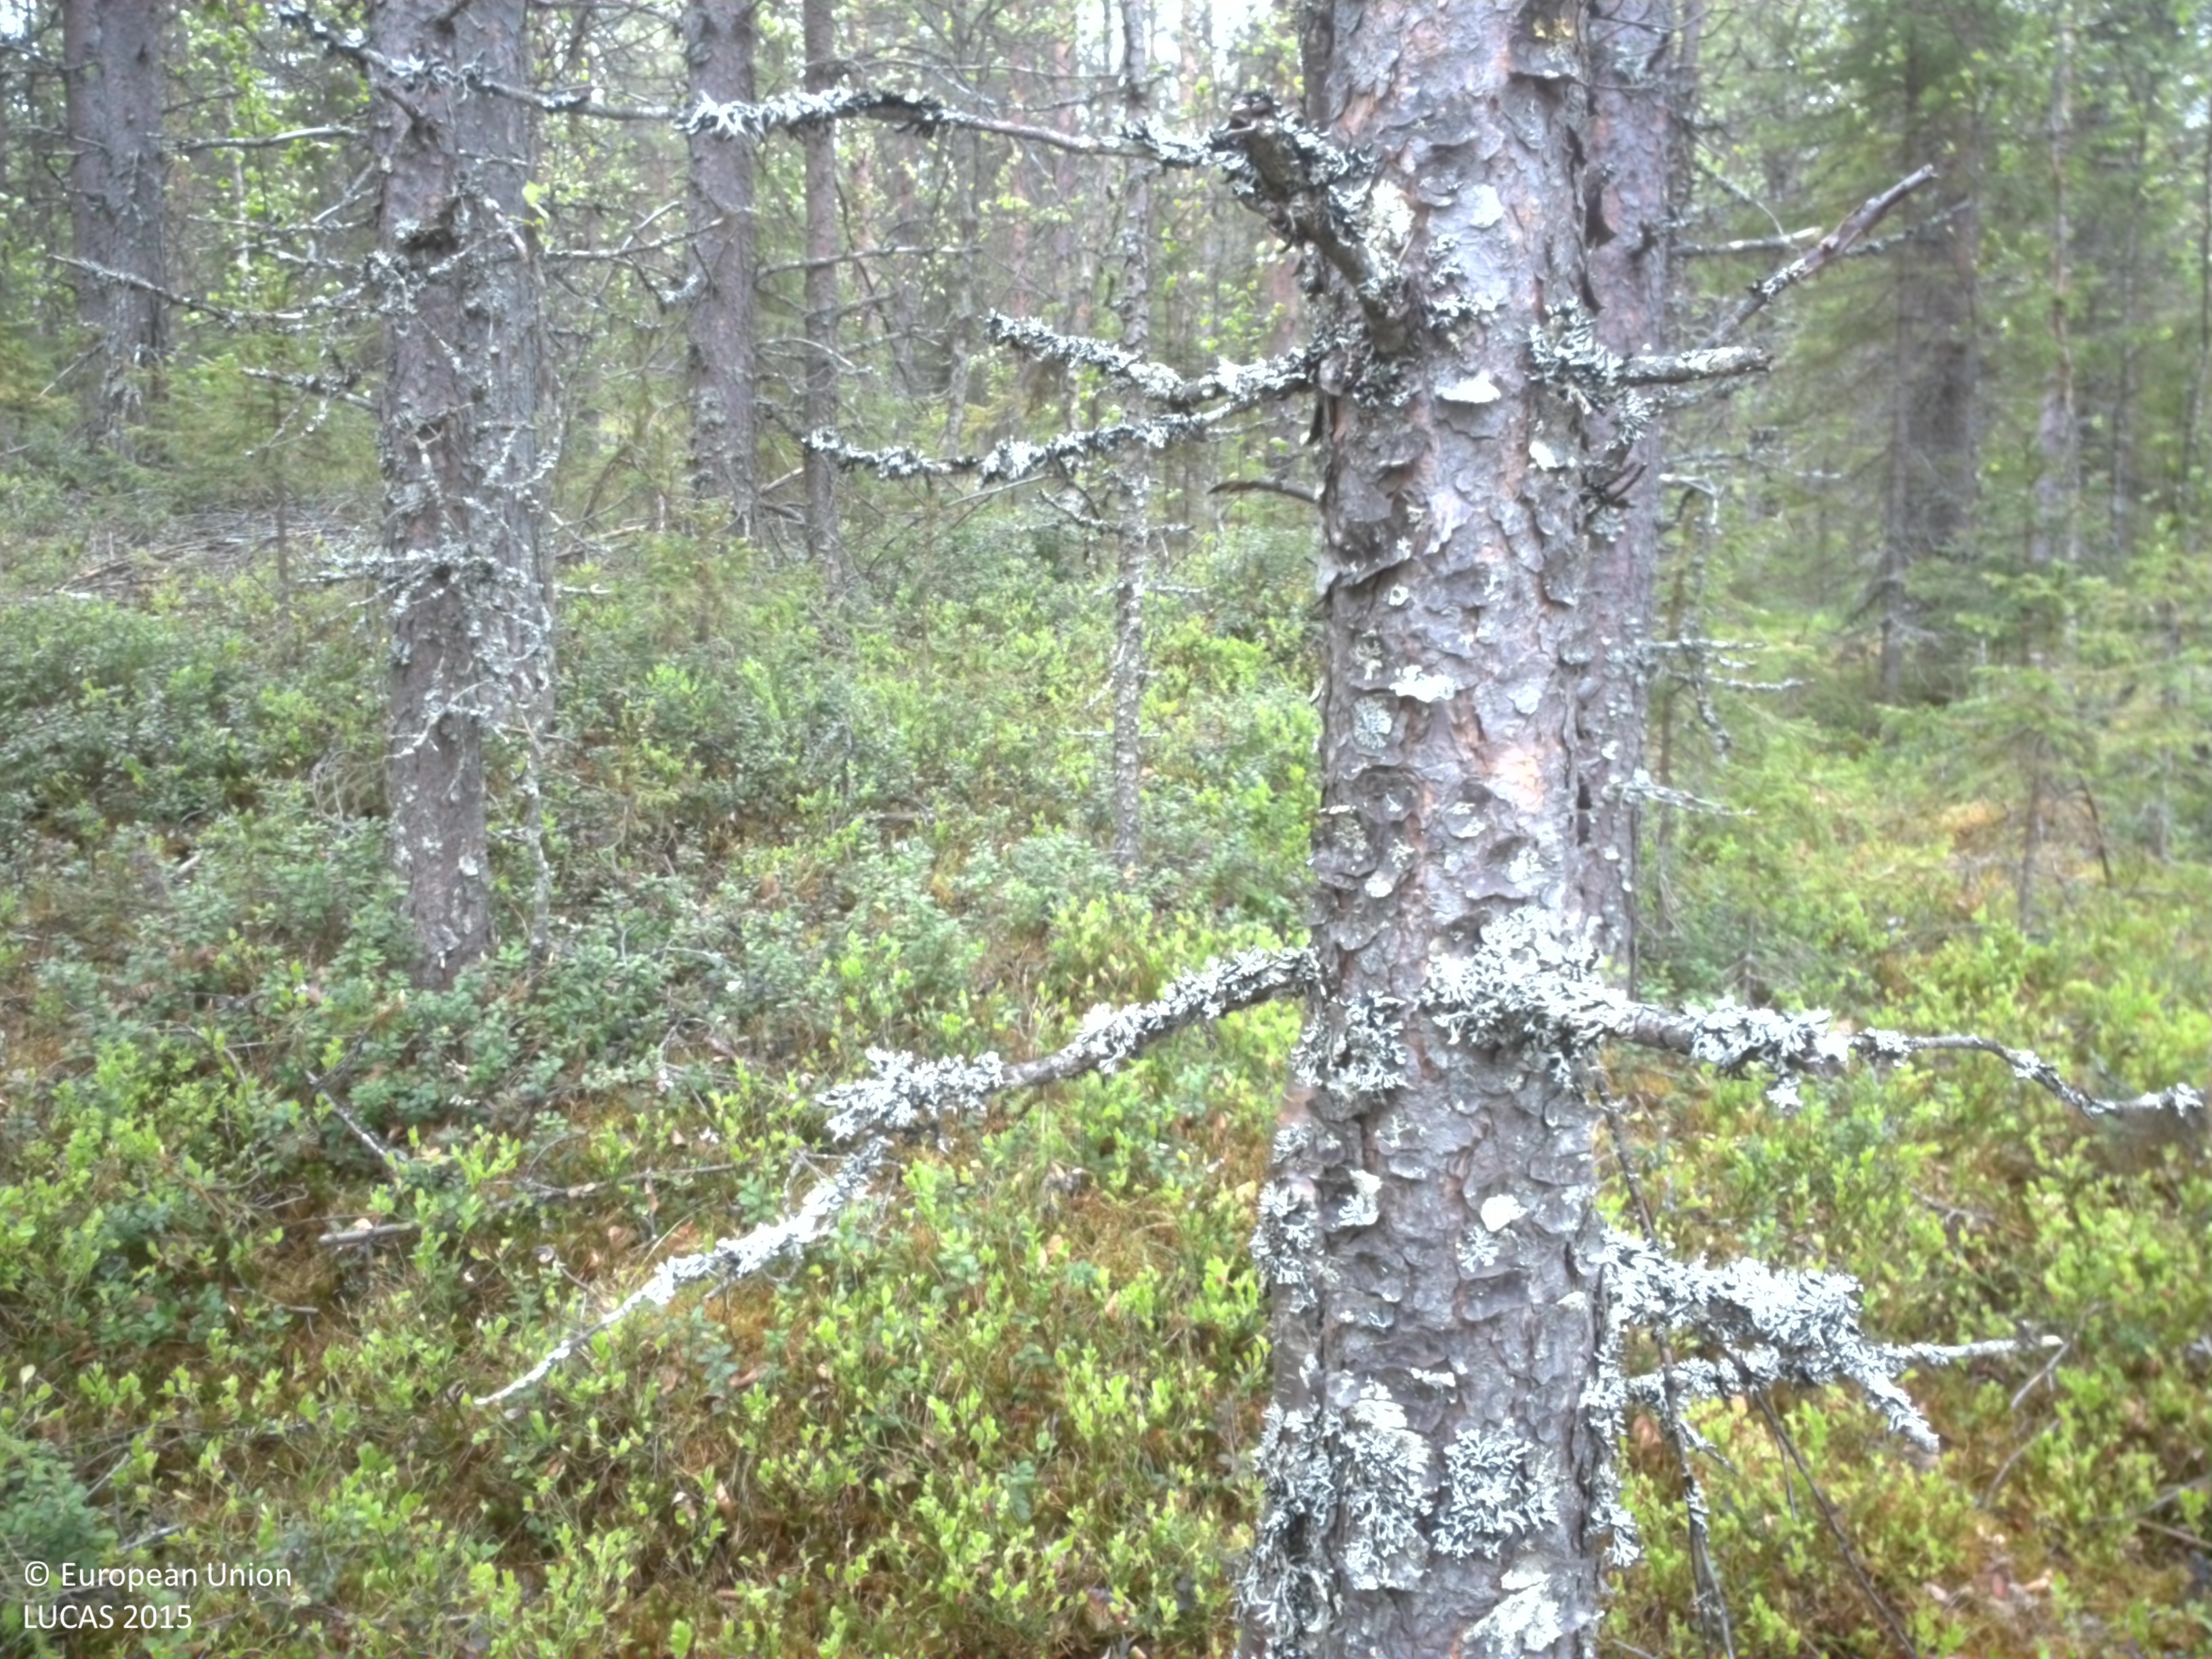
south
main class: Woodland
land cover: Pine dominated mixed woodland
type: boreal forest
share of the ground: 25 - 50 %
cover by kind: herbaceous plants 40 %, coniferous forest trees 25 %, lichens and mosses 15 %, broadleaved forest trees 10 %, shrubs 10 %
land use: Forestry
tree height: > 5 m
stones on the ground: < 10 %
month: June
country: SE
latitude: 66.6990
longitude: 22.4056
